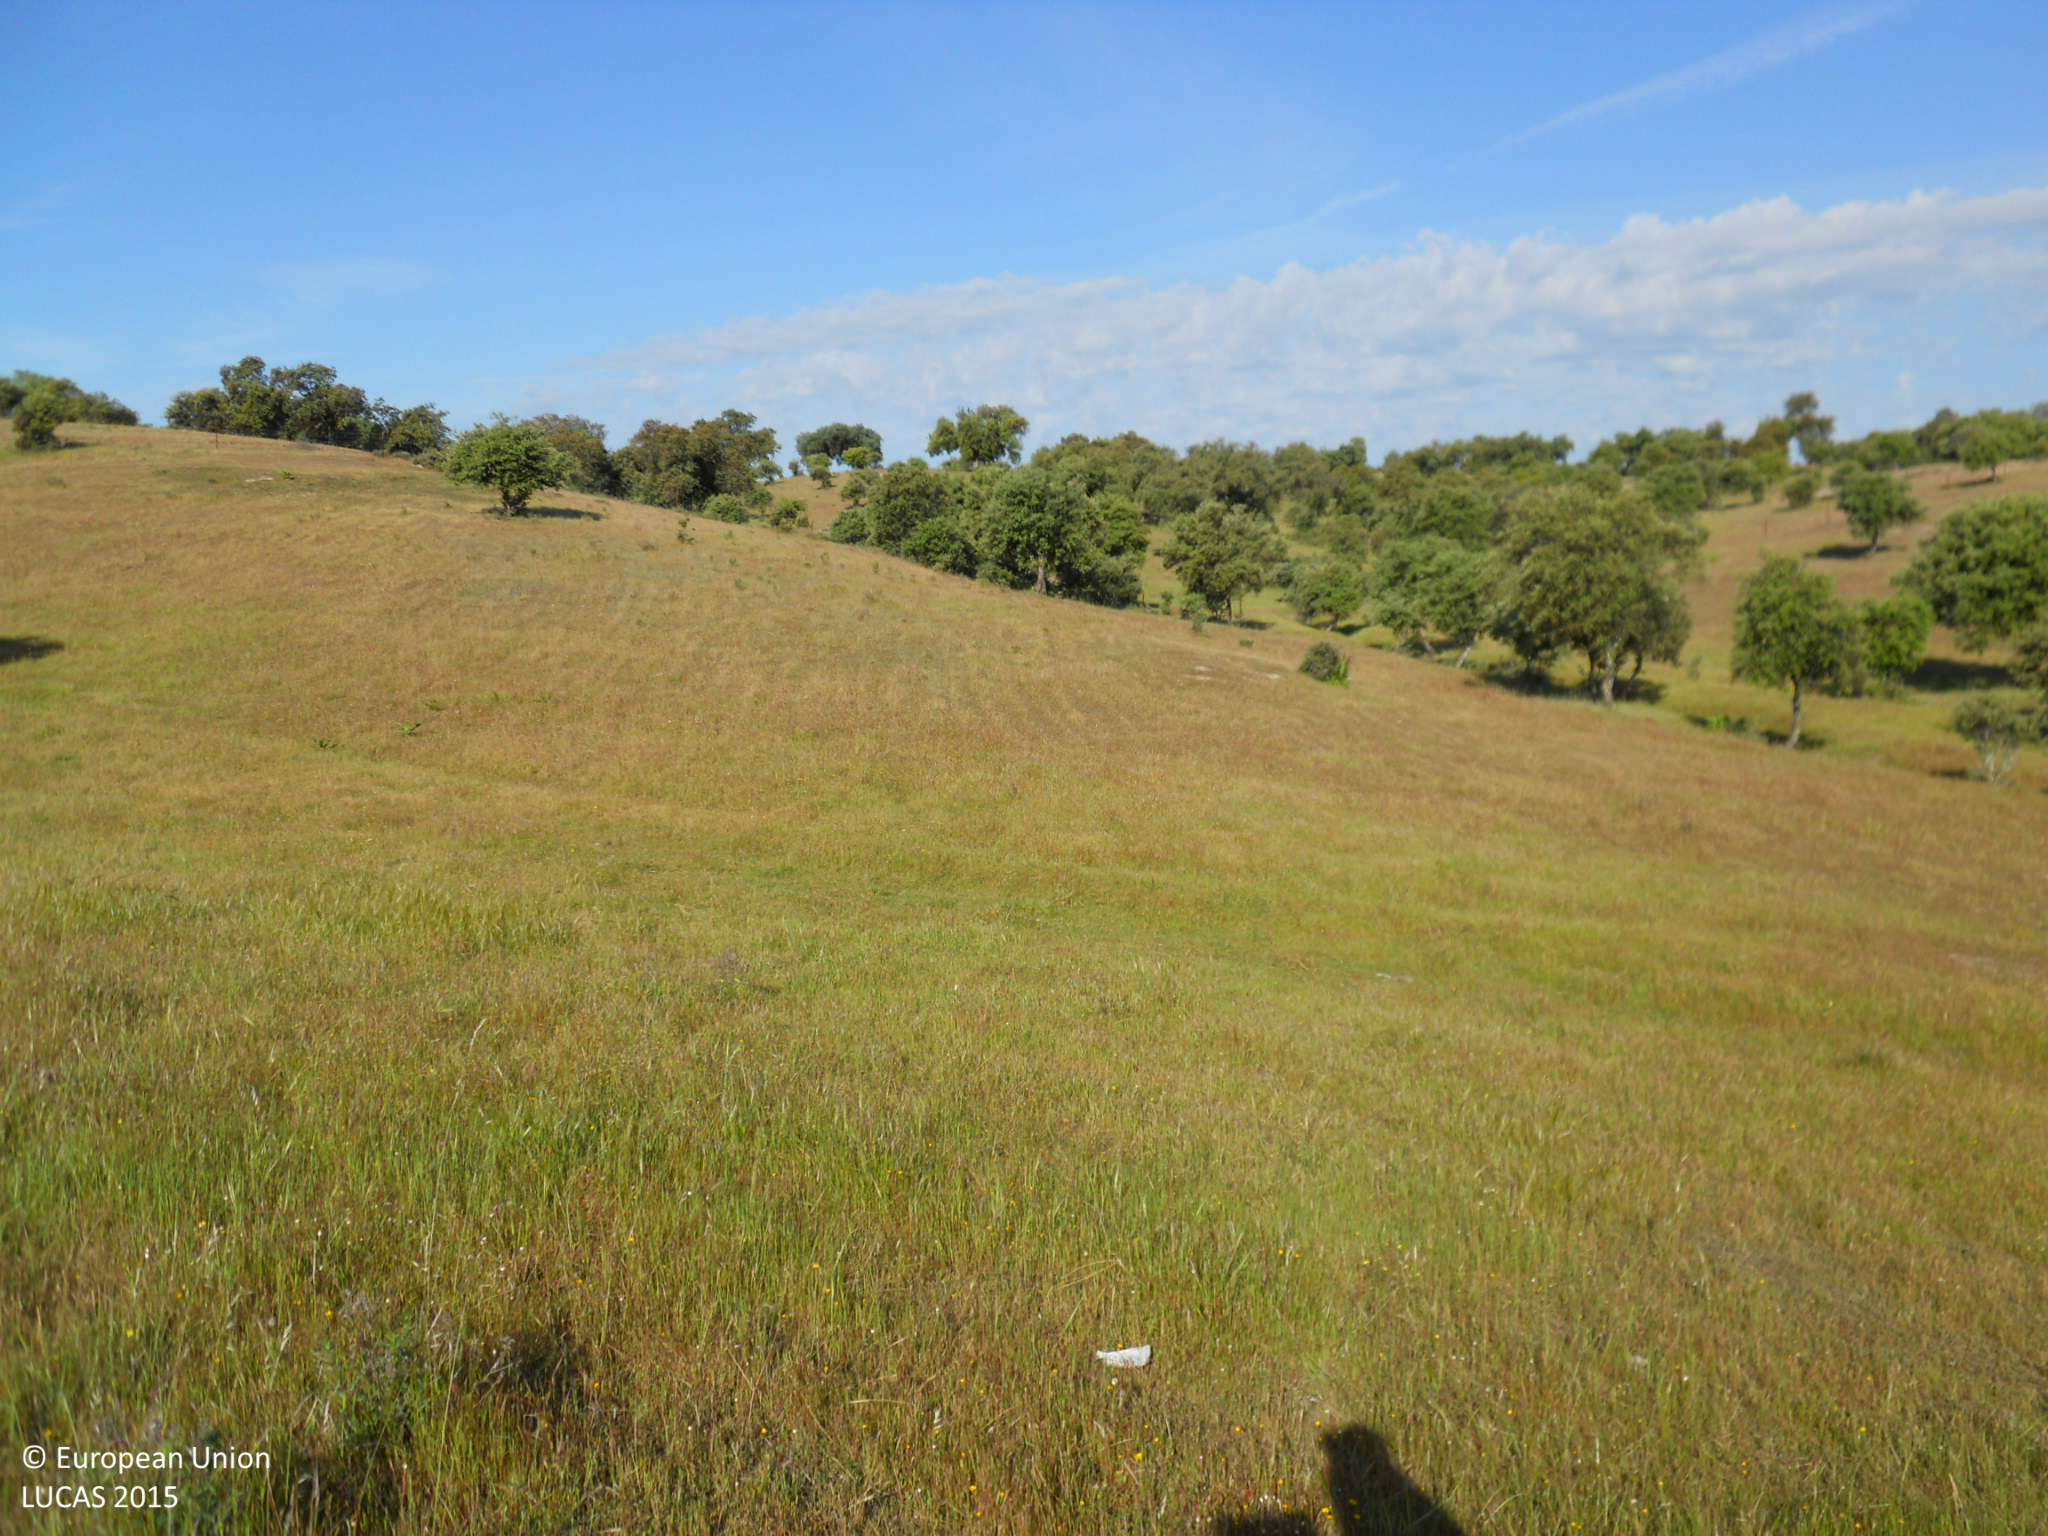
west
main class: Grassland
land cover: Grassland without tree/shrub cover
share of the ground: > 75 %
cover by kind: herbaceous plants 95 %, shrubs 5 %
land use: Agriculture (excluding fallow land and kitchen gardens)
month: April
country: ES
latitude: 39.2265
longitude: -6.9296
